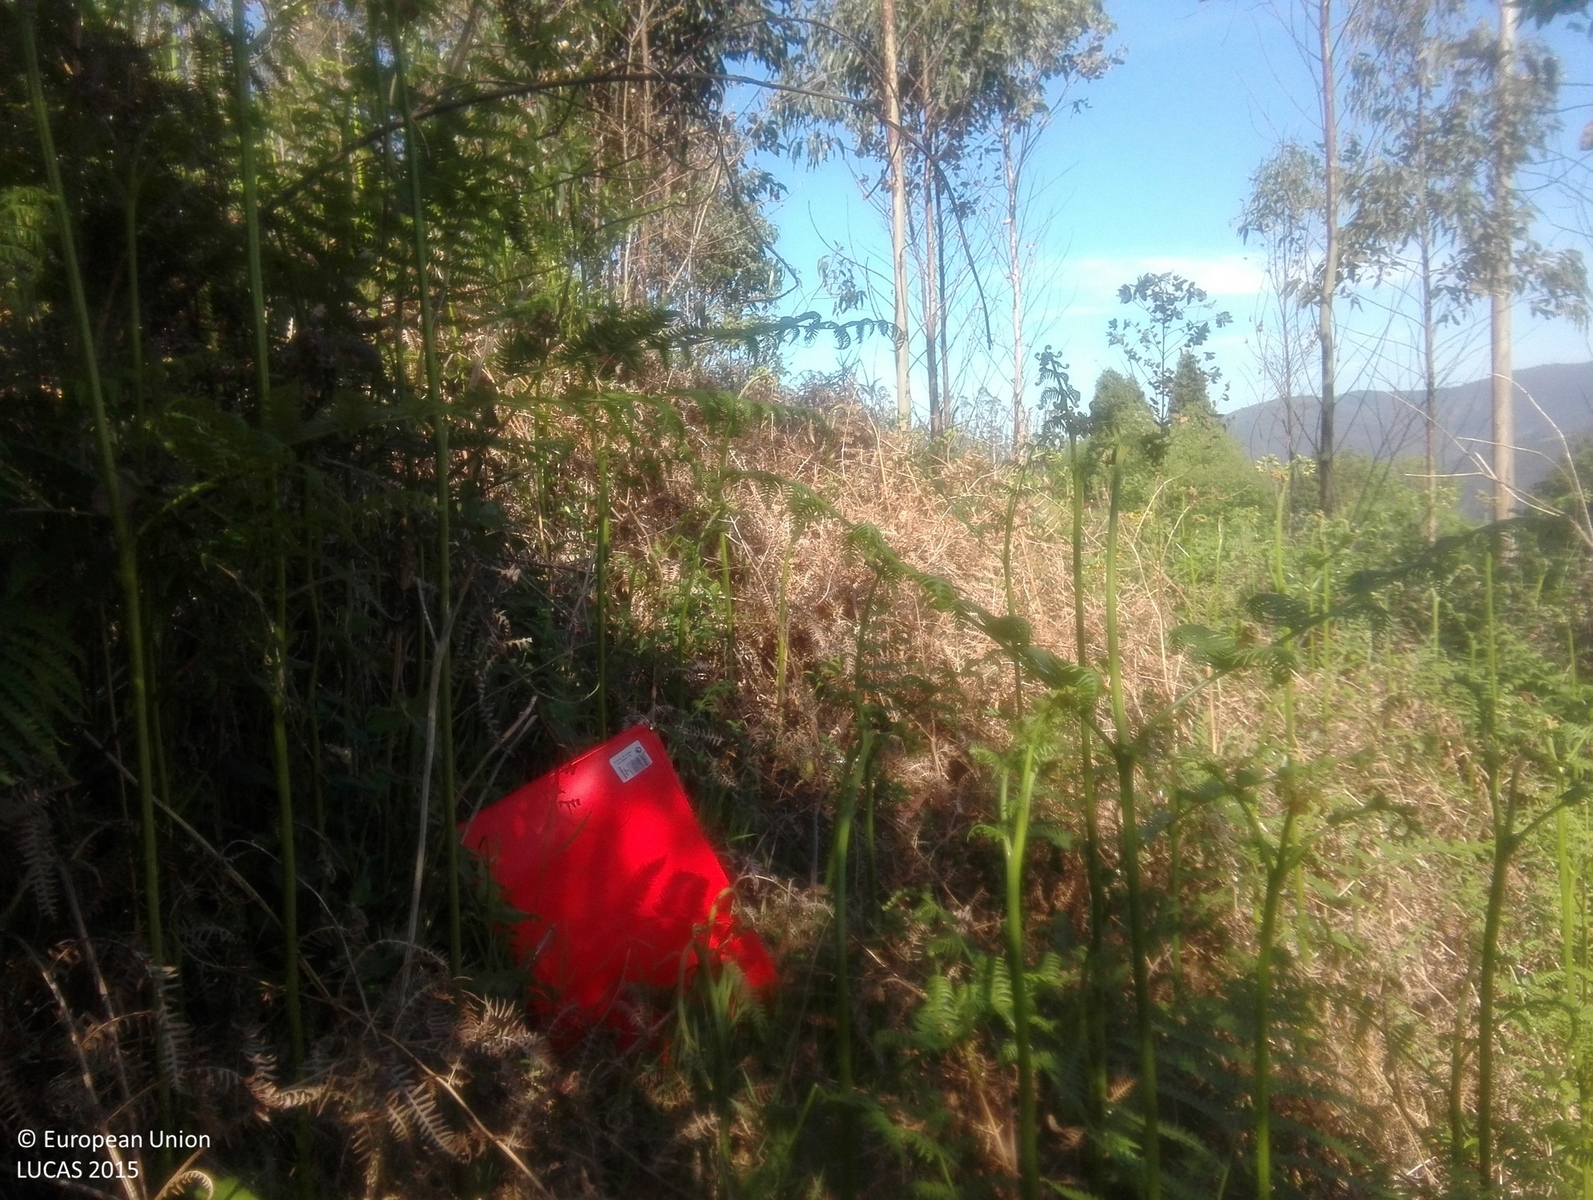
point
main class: Woodland
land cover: Broadleaved woodland
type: exotic forest
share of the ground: 50 - 75 %
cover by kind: broadleaved forest trees 70 %, shrubs 30 %
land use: Forestry
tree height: > 5 m
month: April
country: ES
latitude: 43.4245
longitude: -7.1541
